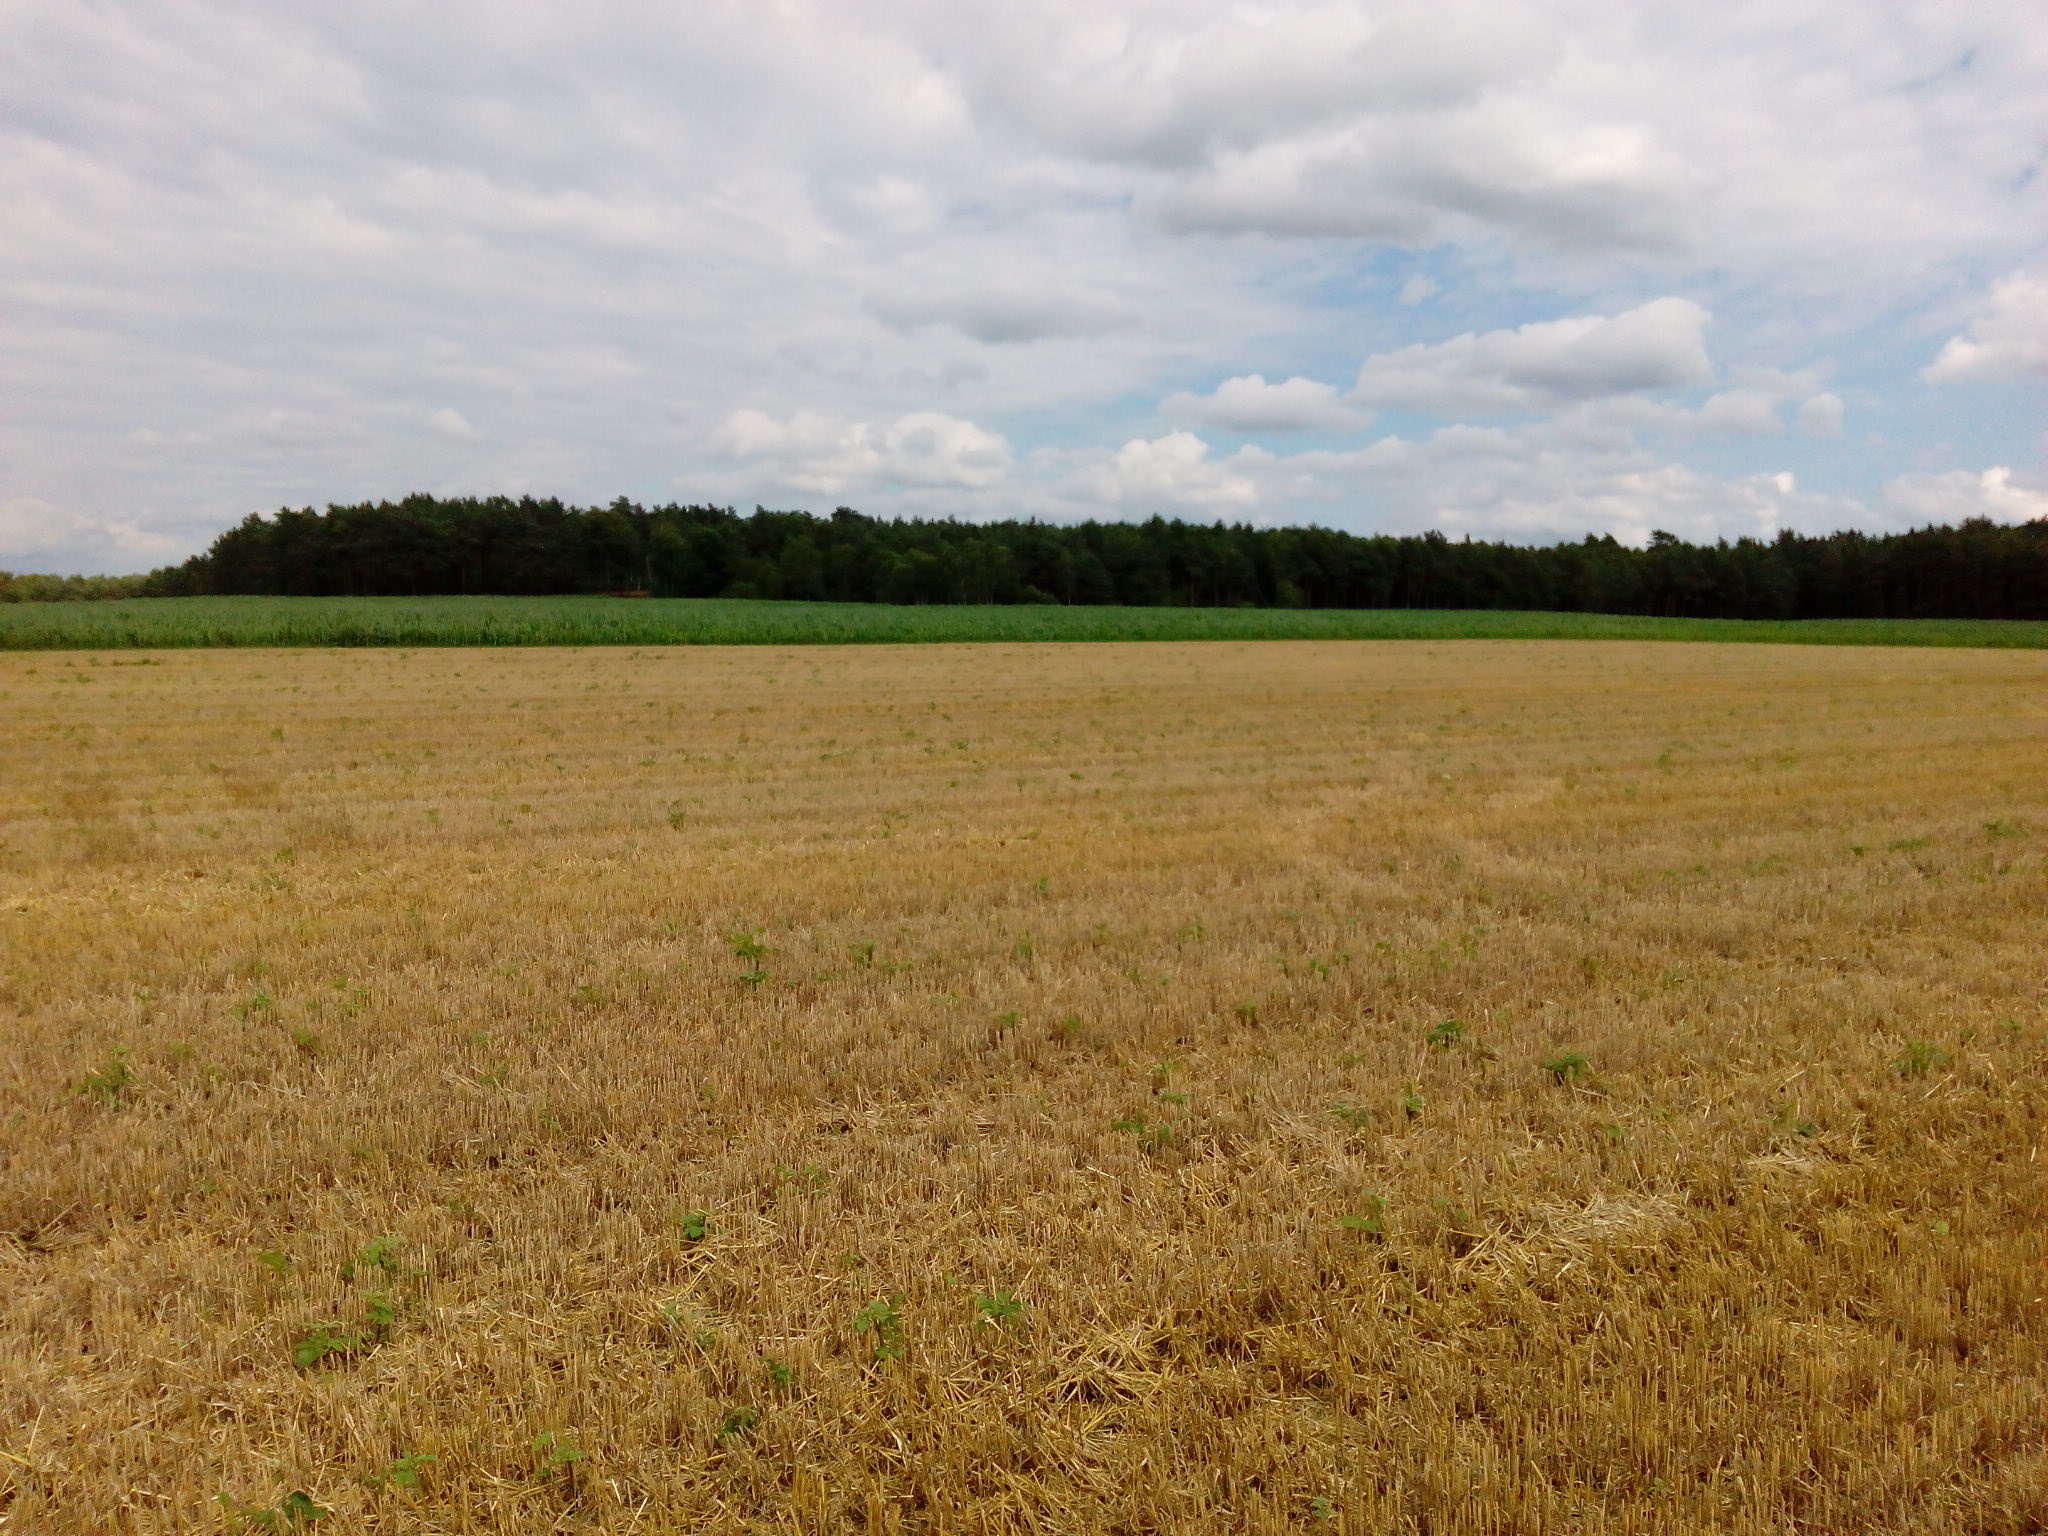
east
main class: Cropland
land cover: Rye
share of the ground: > 75 %
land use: Agriculture (excluding fallow land and kitchen gardens)
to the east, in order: Rye; Grass margins; Maize
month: July
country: DE
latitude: 52.9705
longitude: 9.8660
